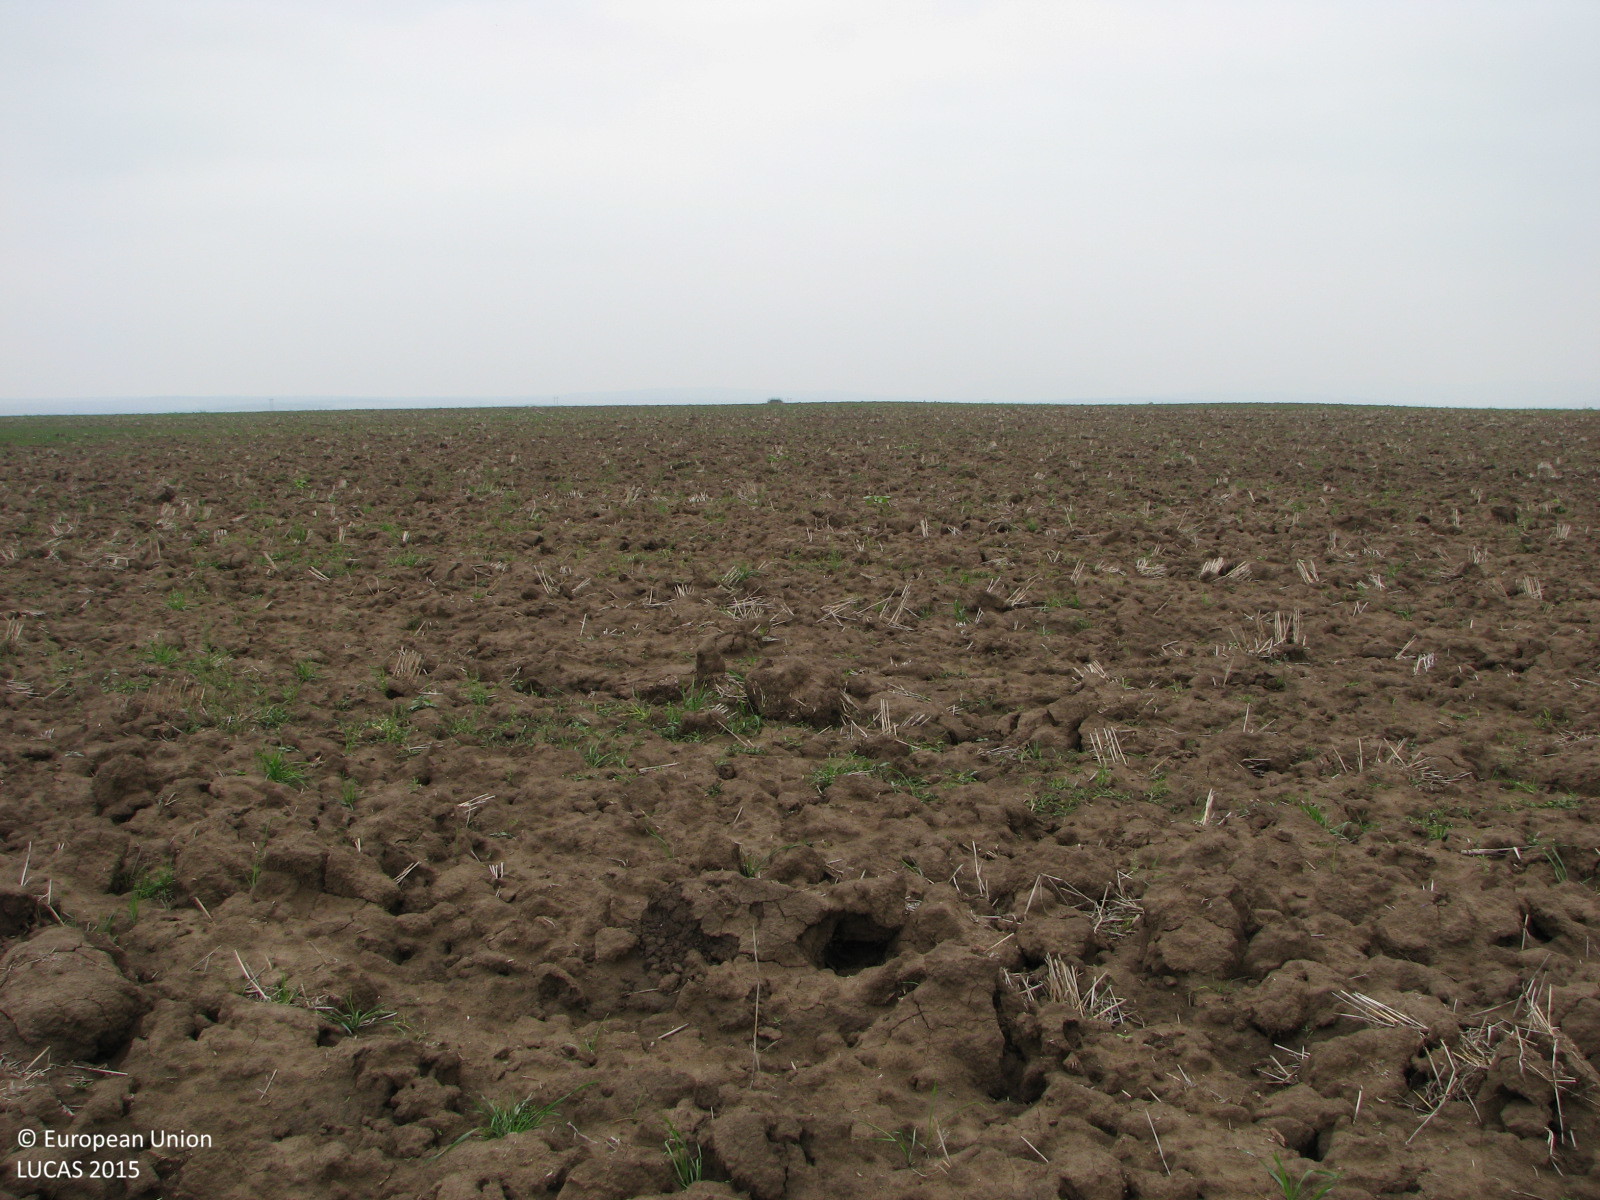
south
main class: Cropland
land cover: Common wheat
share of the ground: < 10 %
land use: Agriculture (excluding fallow land and kitchen gardens)
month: October
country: BG
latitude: 42.5896
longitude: 26.7579
